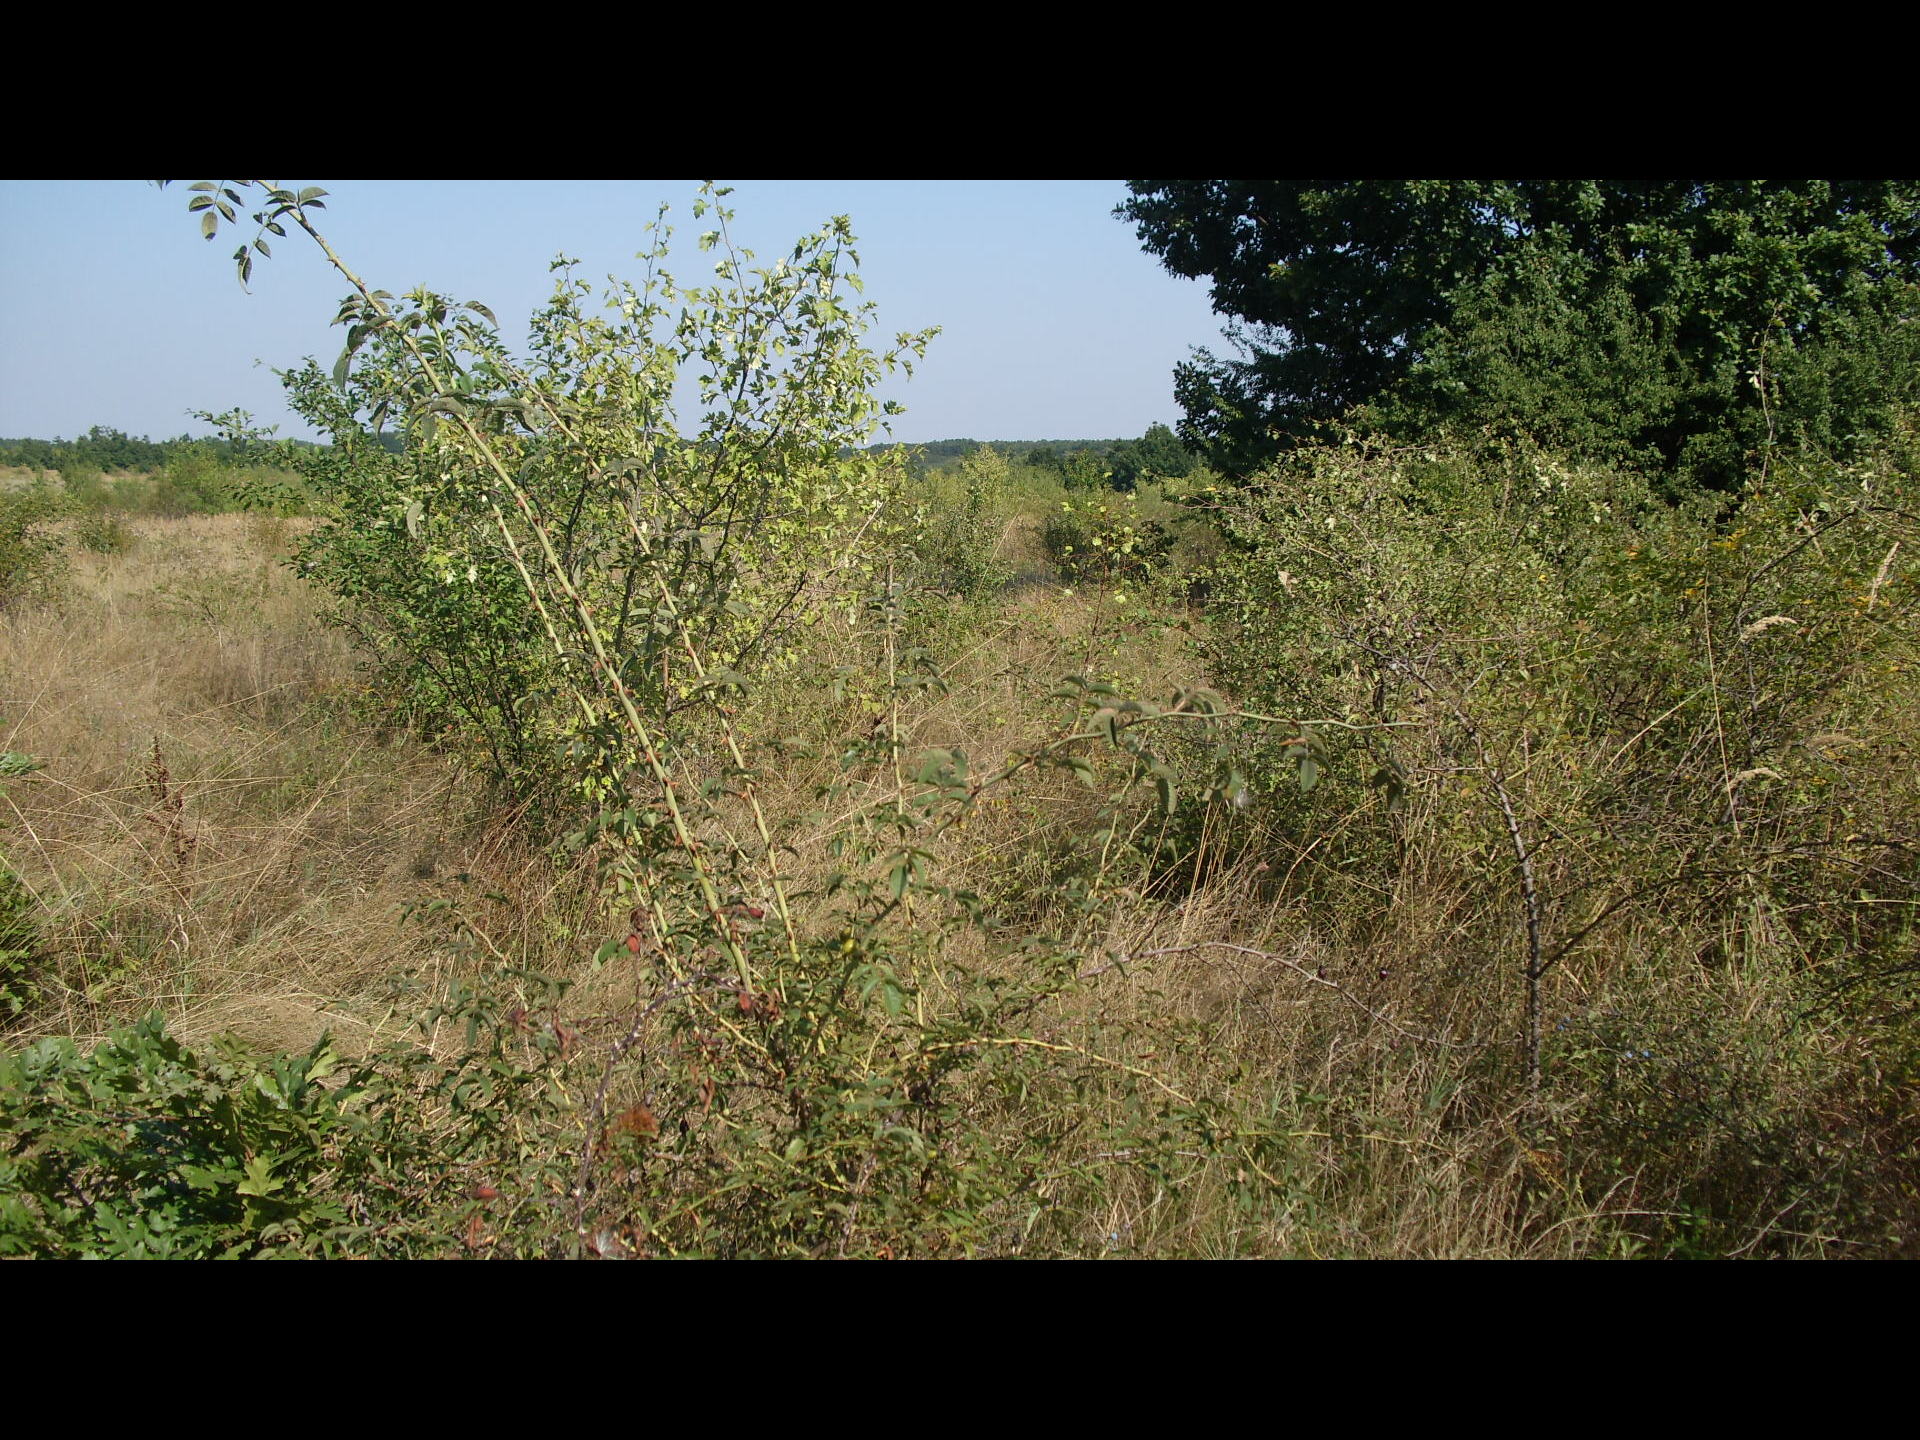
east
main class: Grassland
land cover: Grassland with sparse tree/shrub cover
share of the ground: > 75 %
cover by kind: herbaceous plants 90 %, broadleaved forest trees 5 %, shrubs 5 %
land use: Semi-natural and natural areas not in use
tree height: < 5 m
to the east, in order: Grassland with sparse tree/shrub cover; Shrubland without tree cover; Grassland with sparse tree/shrub cover; Shrubland without tree cover
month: September
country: BG
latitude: 44.0026
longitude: 22.4175
